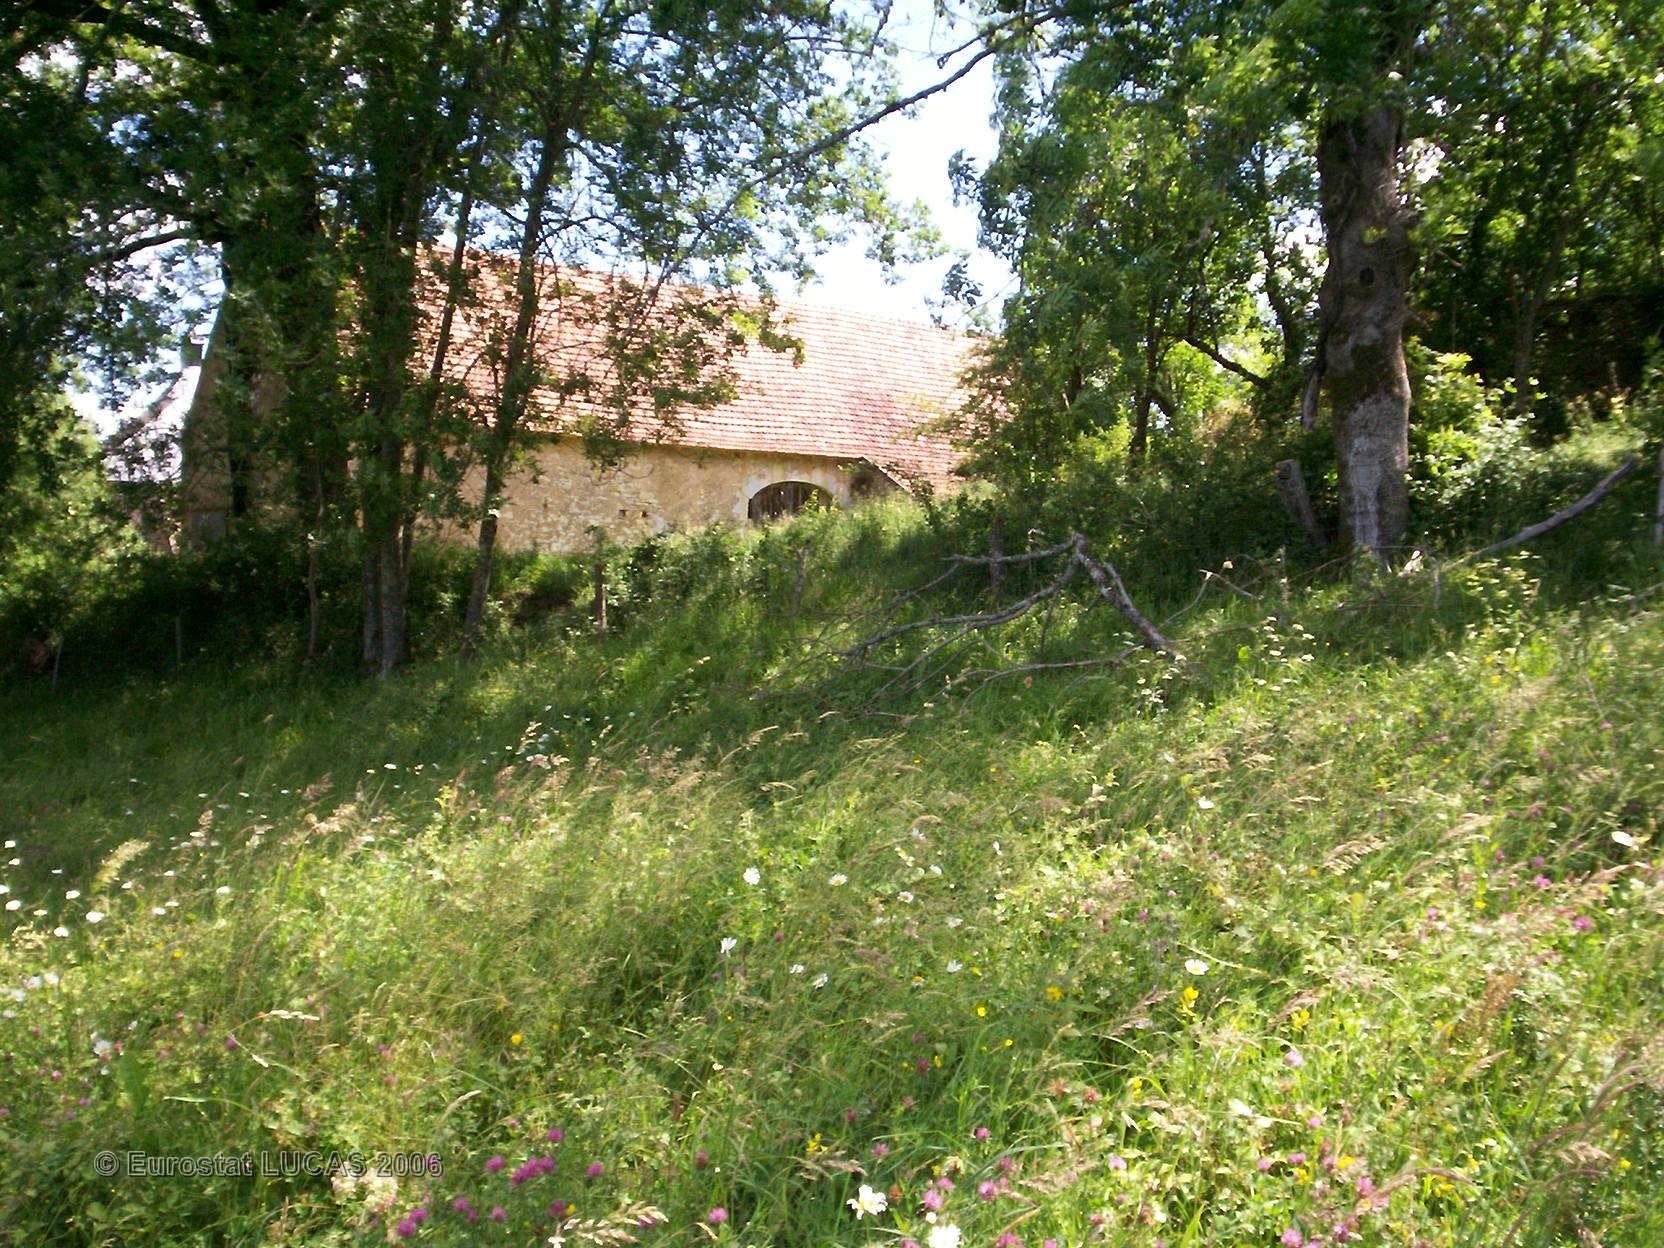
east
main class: Grassland
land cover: Grassland without tree/shrub cover
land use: Agriculture (excluding fallow land and kitchen gardens)
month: May
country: FR
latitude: 44.6265
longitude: 1.3883
